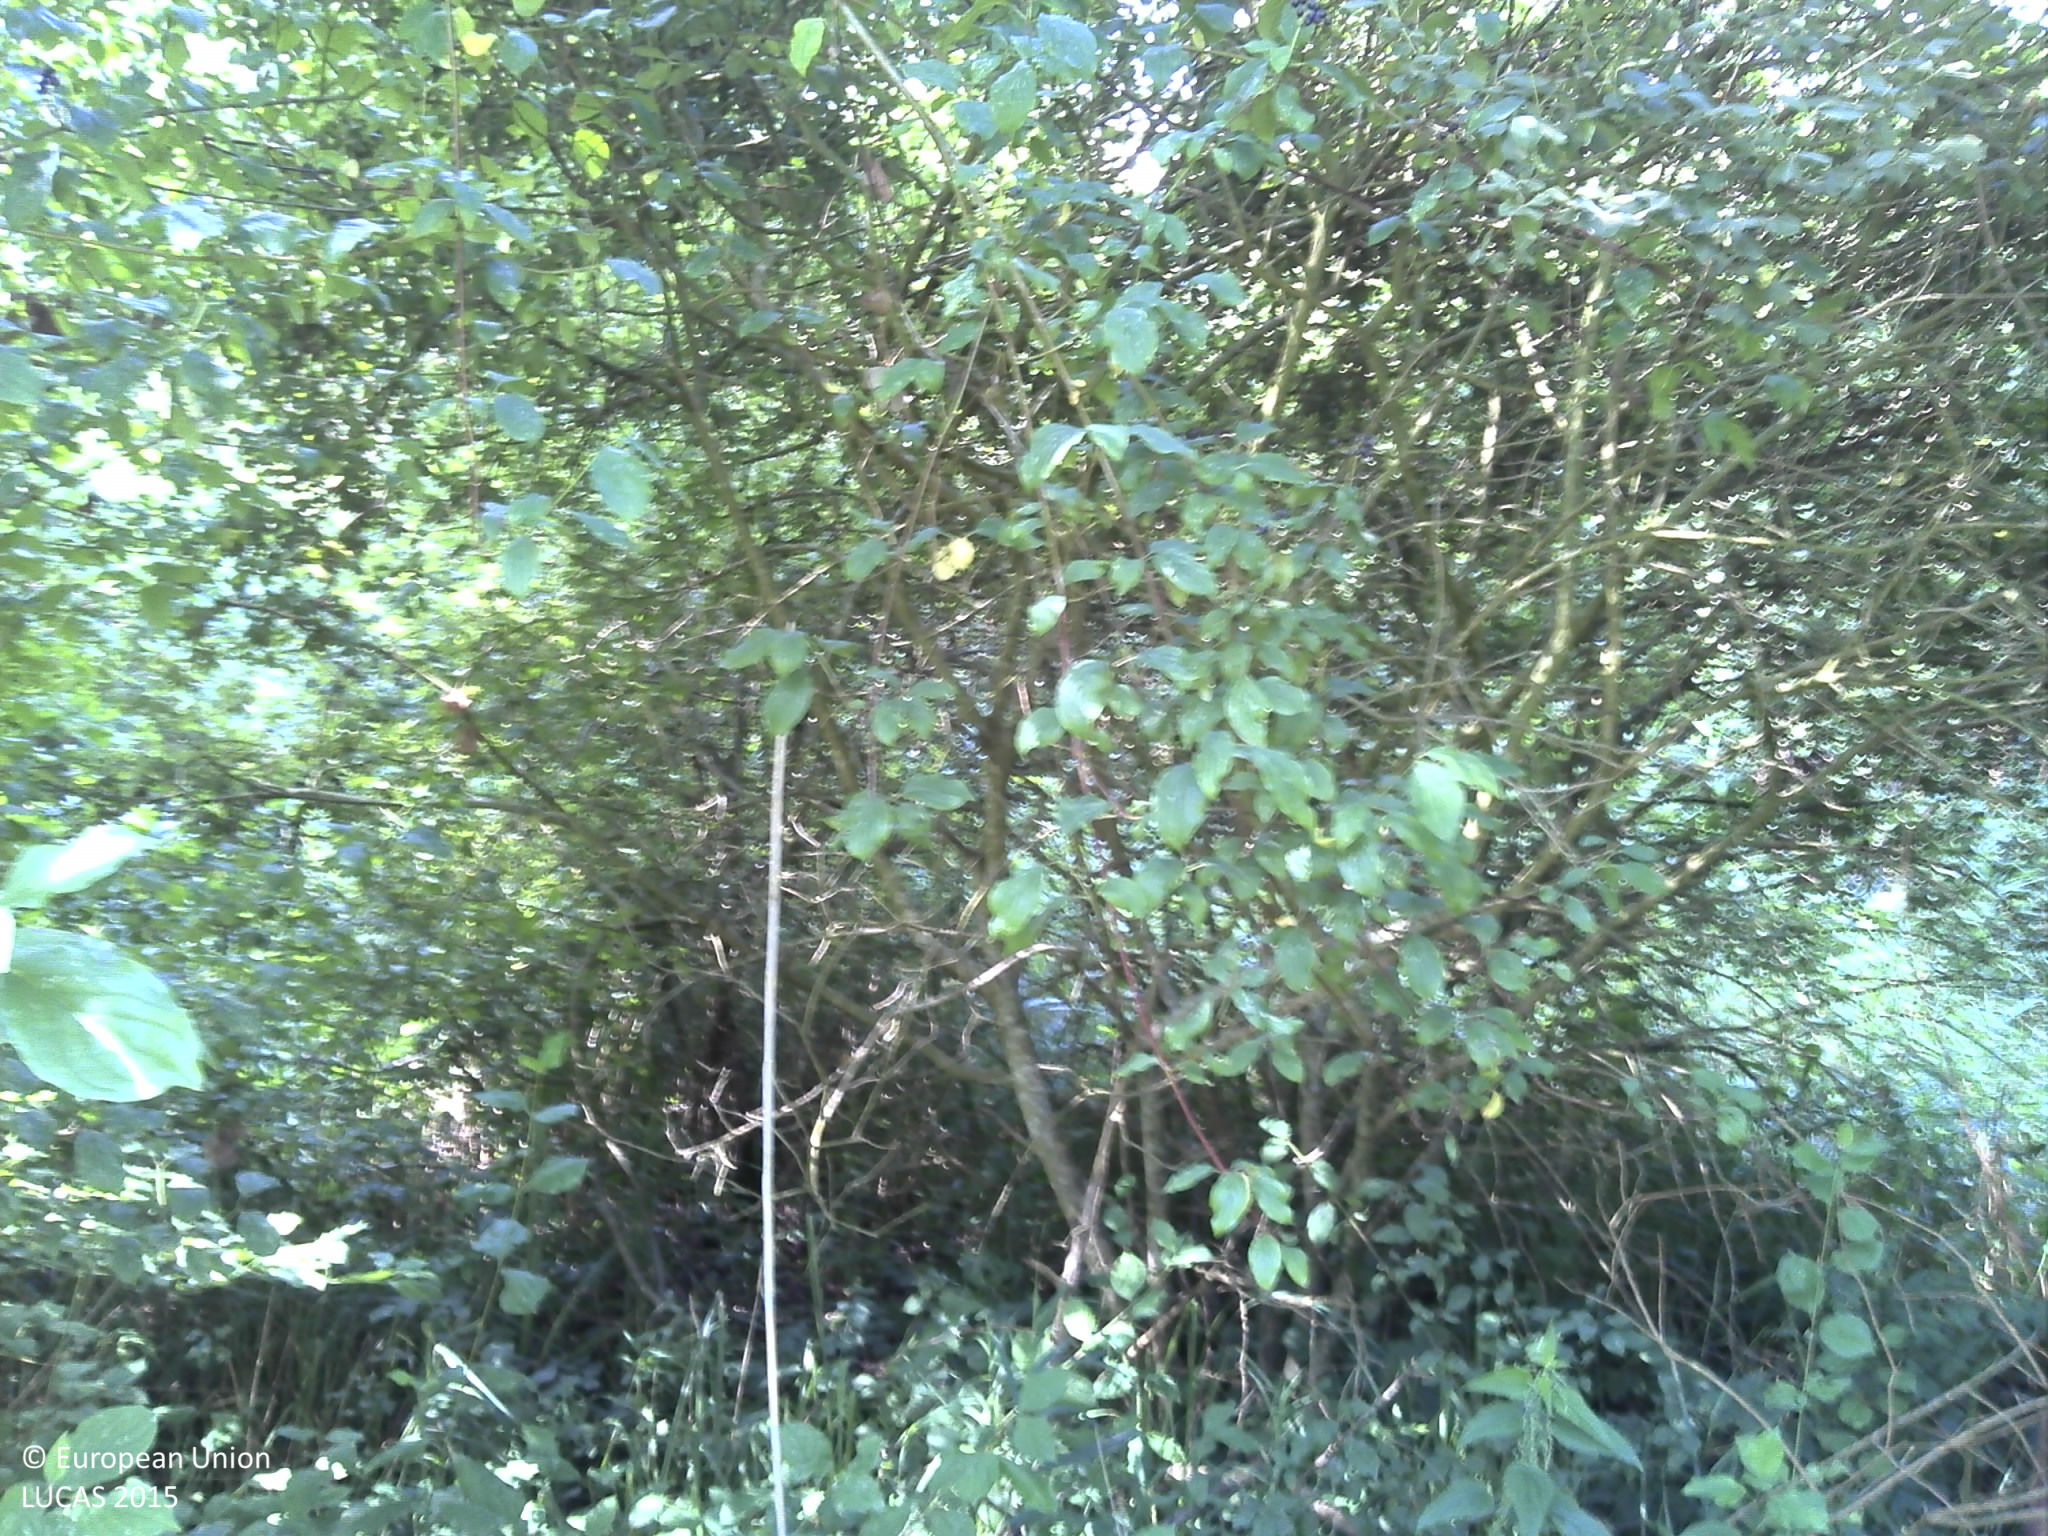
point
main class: Woodland
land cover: Broadleaved woodland
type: exotic forest
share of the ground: > 75 %
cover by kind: broadleaved forest trees 70 %, herbaceous plants 30 %
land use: Forestry
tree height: > 5 m
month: August
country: FR
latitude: 48.4806
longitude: 3.4596
